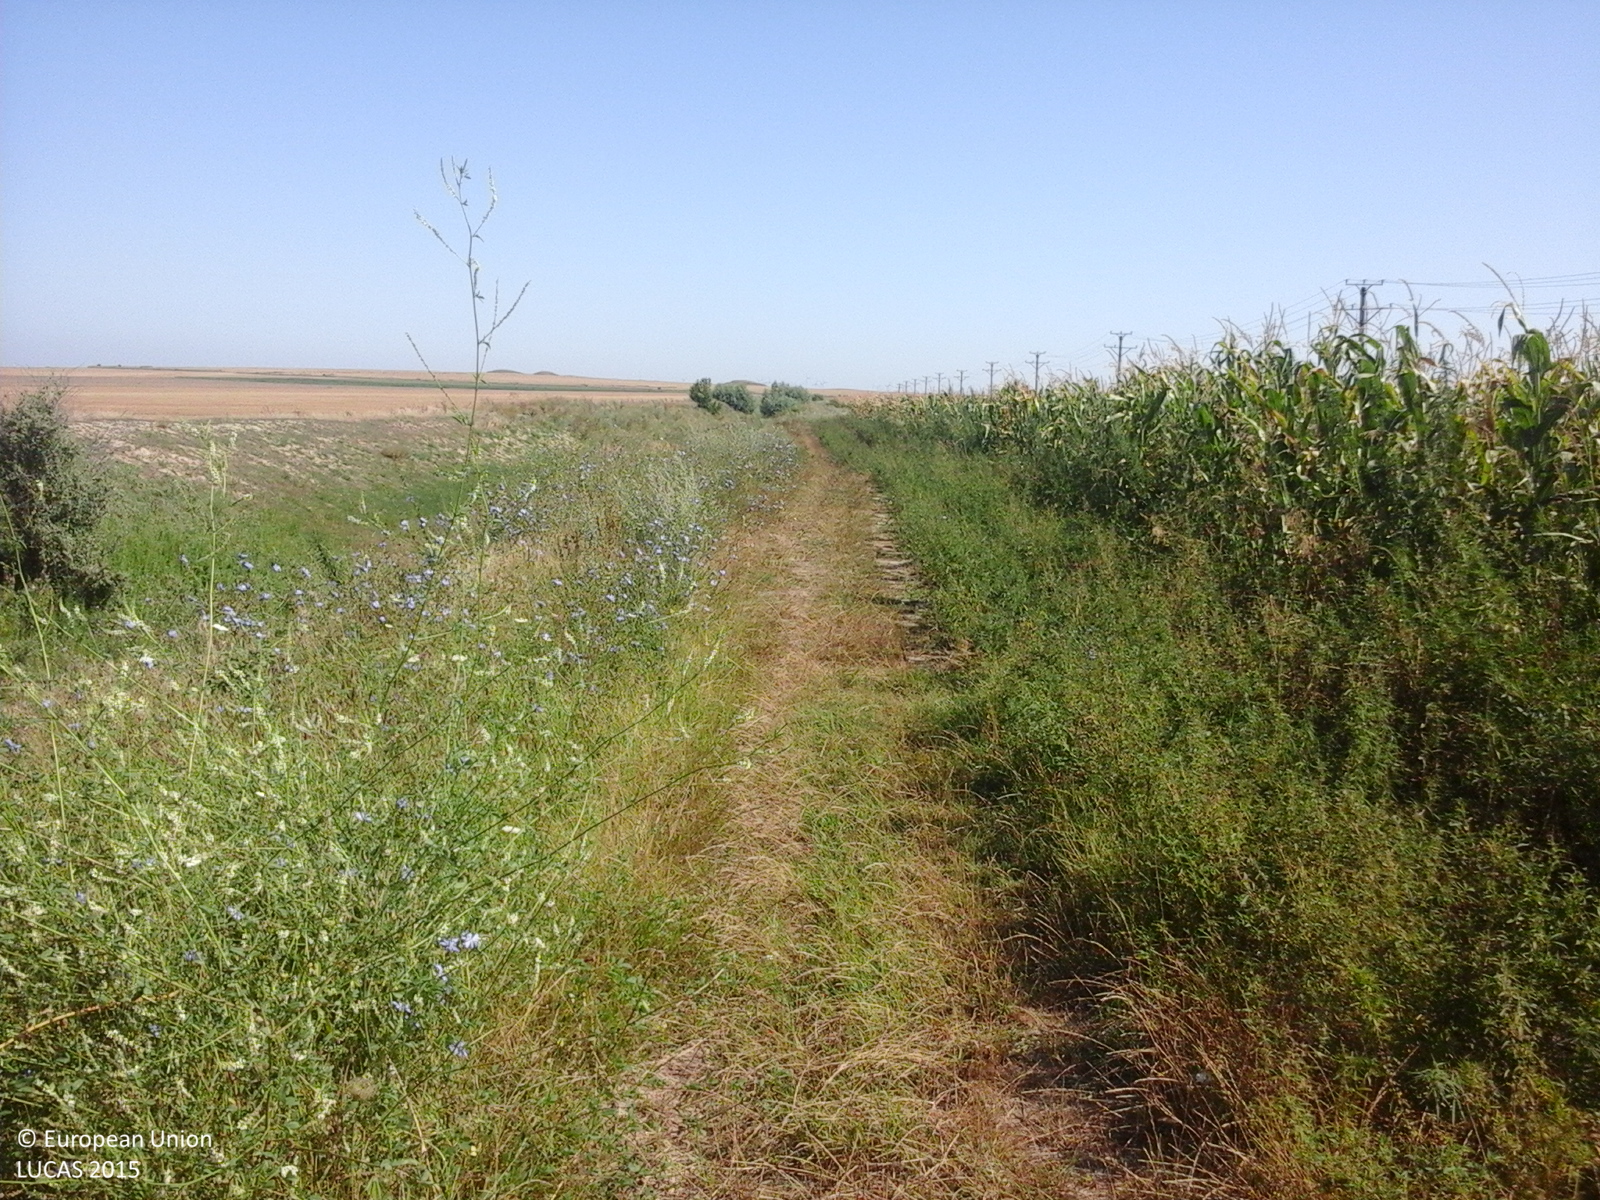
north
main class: Cropland
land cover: Maize
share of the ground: > 75 %
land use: Agriculture (excluding fallow land and kitchen gardens)
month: August
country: RO
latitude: 44.6595
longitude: 28.2133
